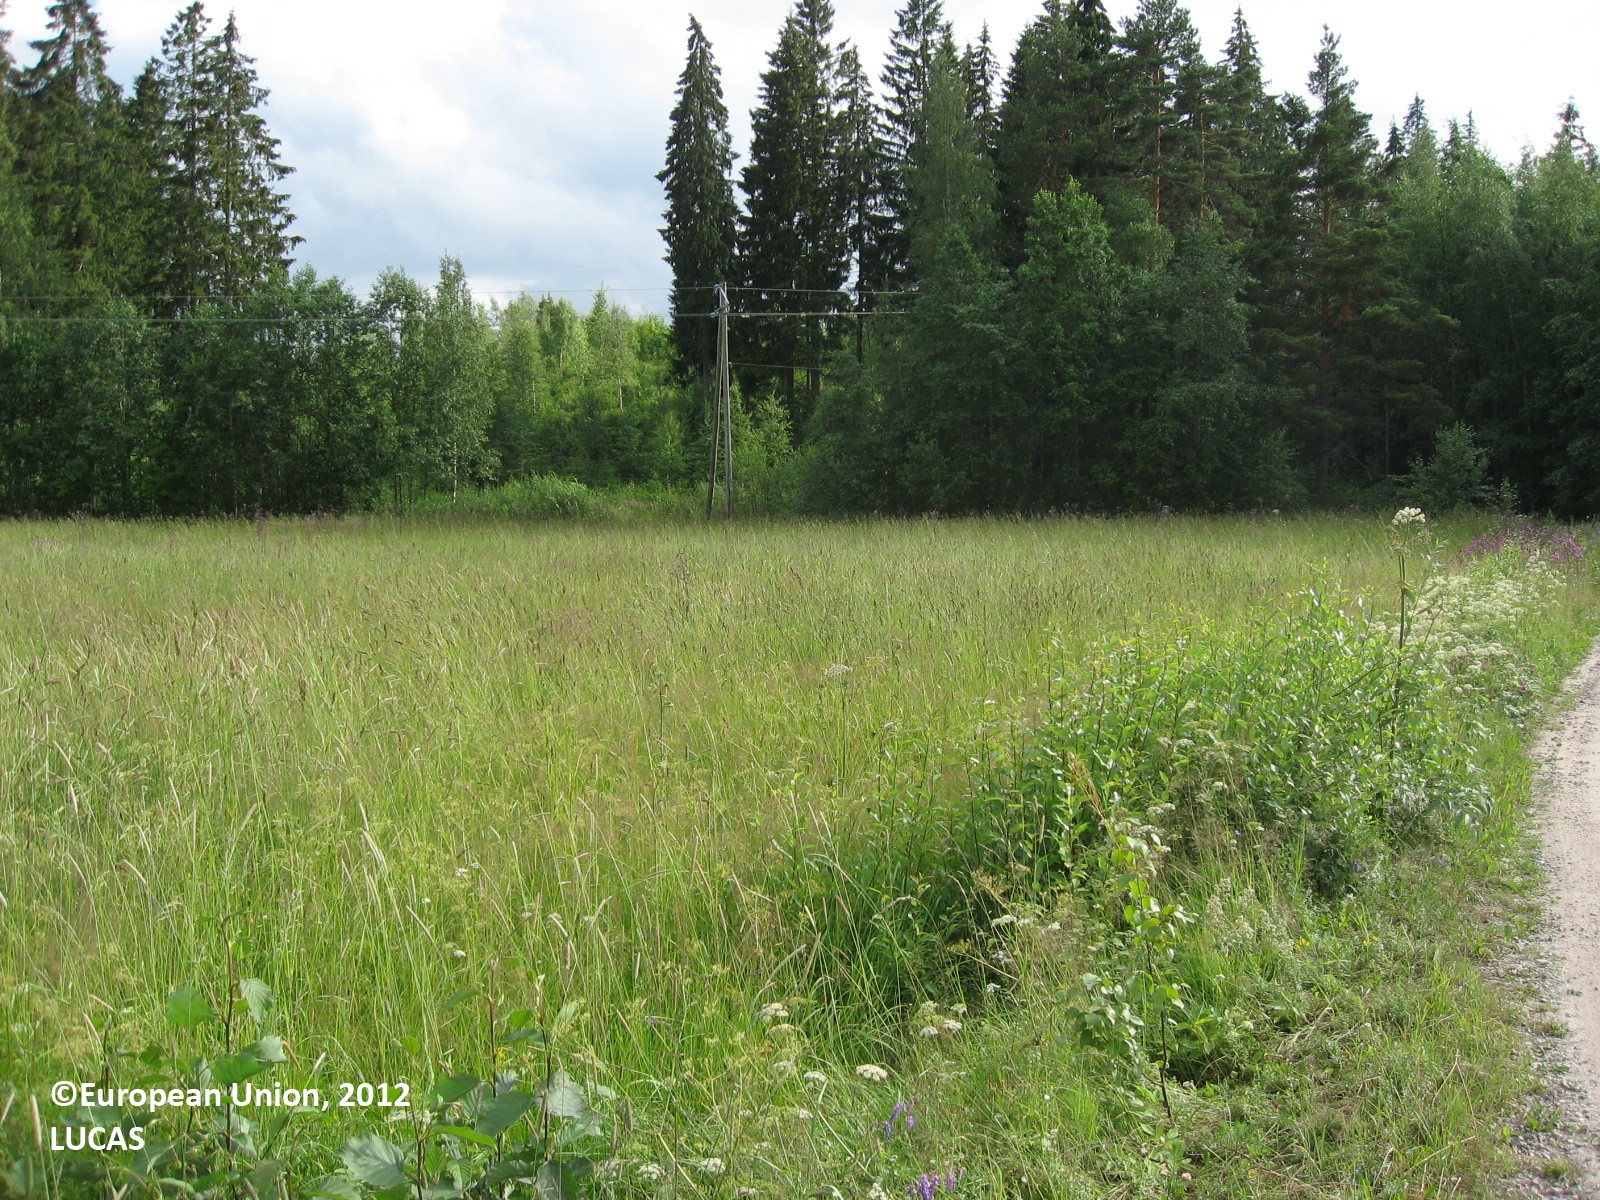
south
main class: Cropland
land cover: Temporary grasslands
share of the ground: > 75 %
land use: Agriculture (excluding fallow land and kitchen gardens)
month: July
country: FI
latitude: 61.0039
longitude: 25.7206
